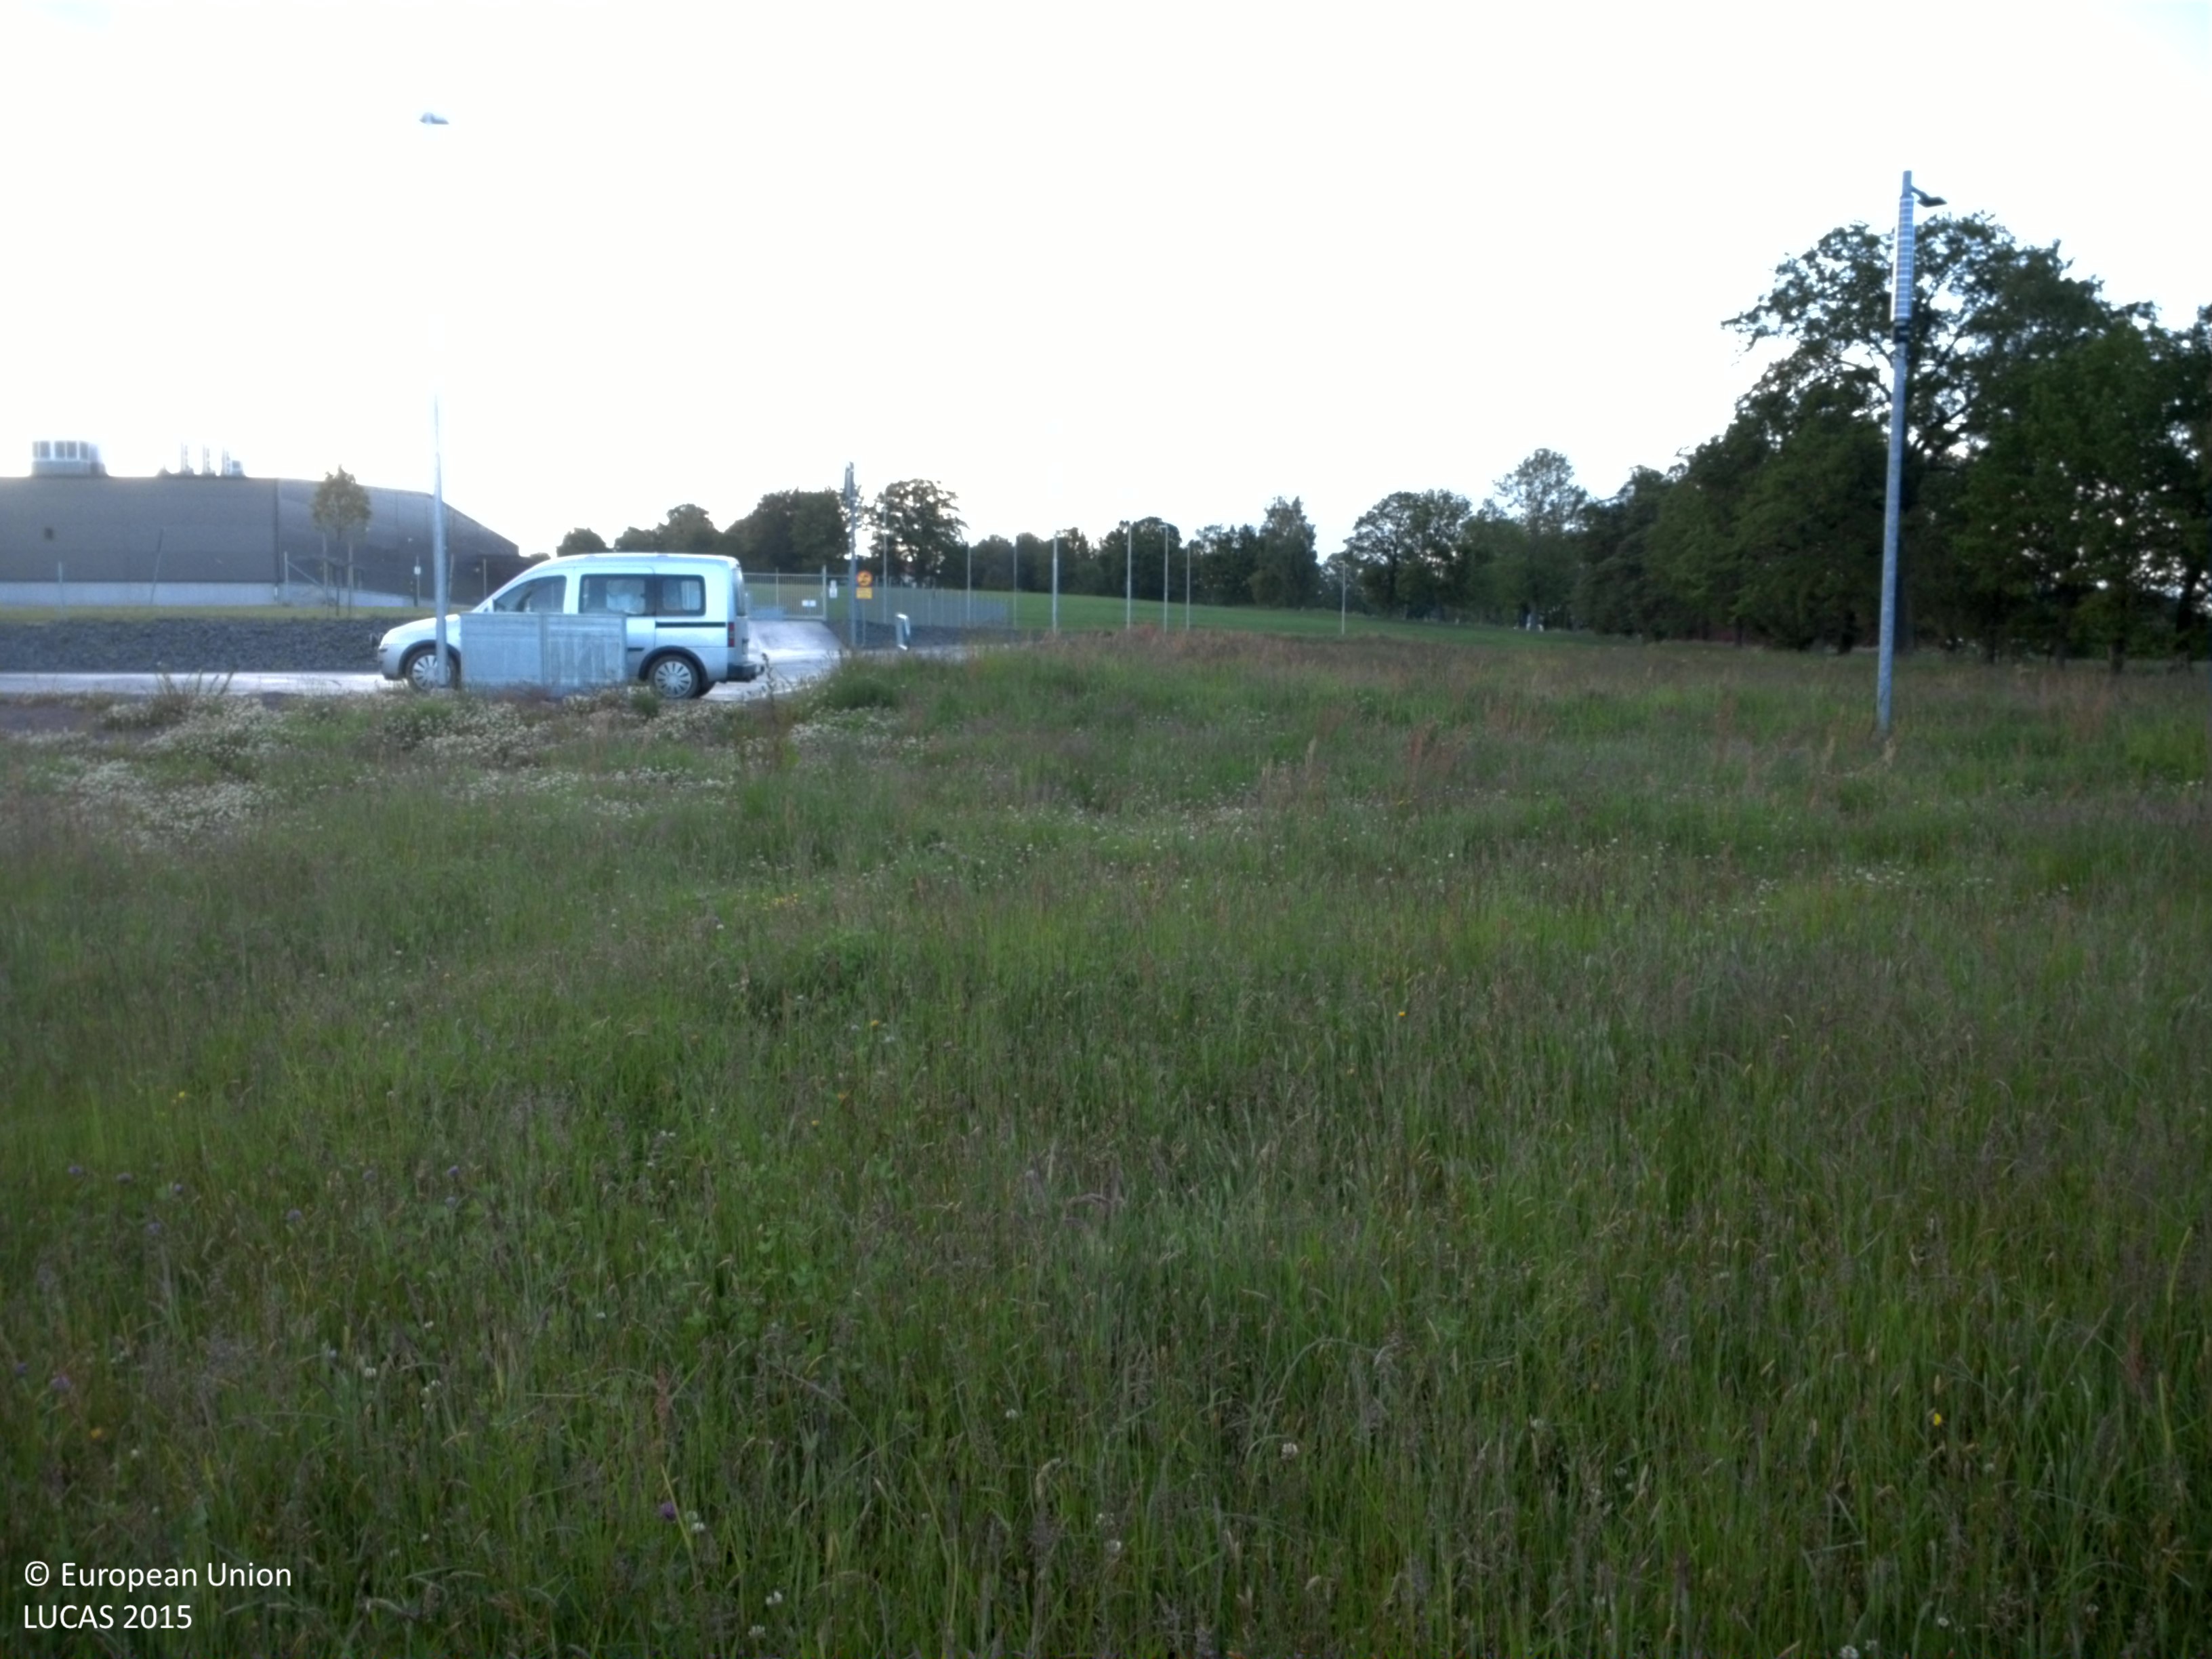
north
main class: Grassland
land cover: Grassland without tree/shrub cover
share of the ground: > 75 %
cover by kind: herbaceous plants 100 %
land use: Agriculture (excluding fallow land and kitchen gardens)
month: June
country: SE
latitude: 58.3136
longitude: 14.2782
